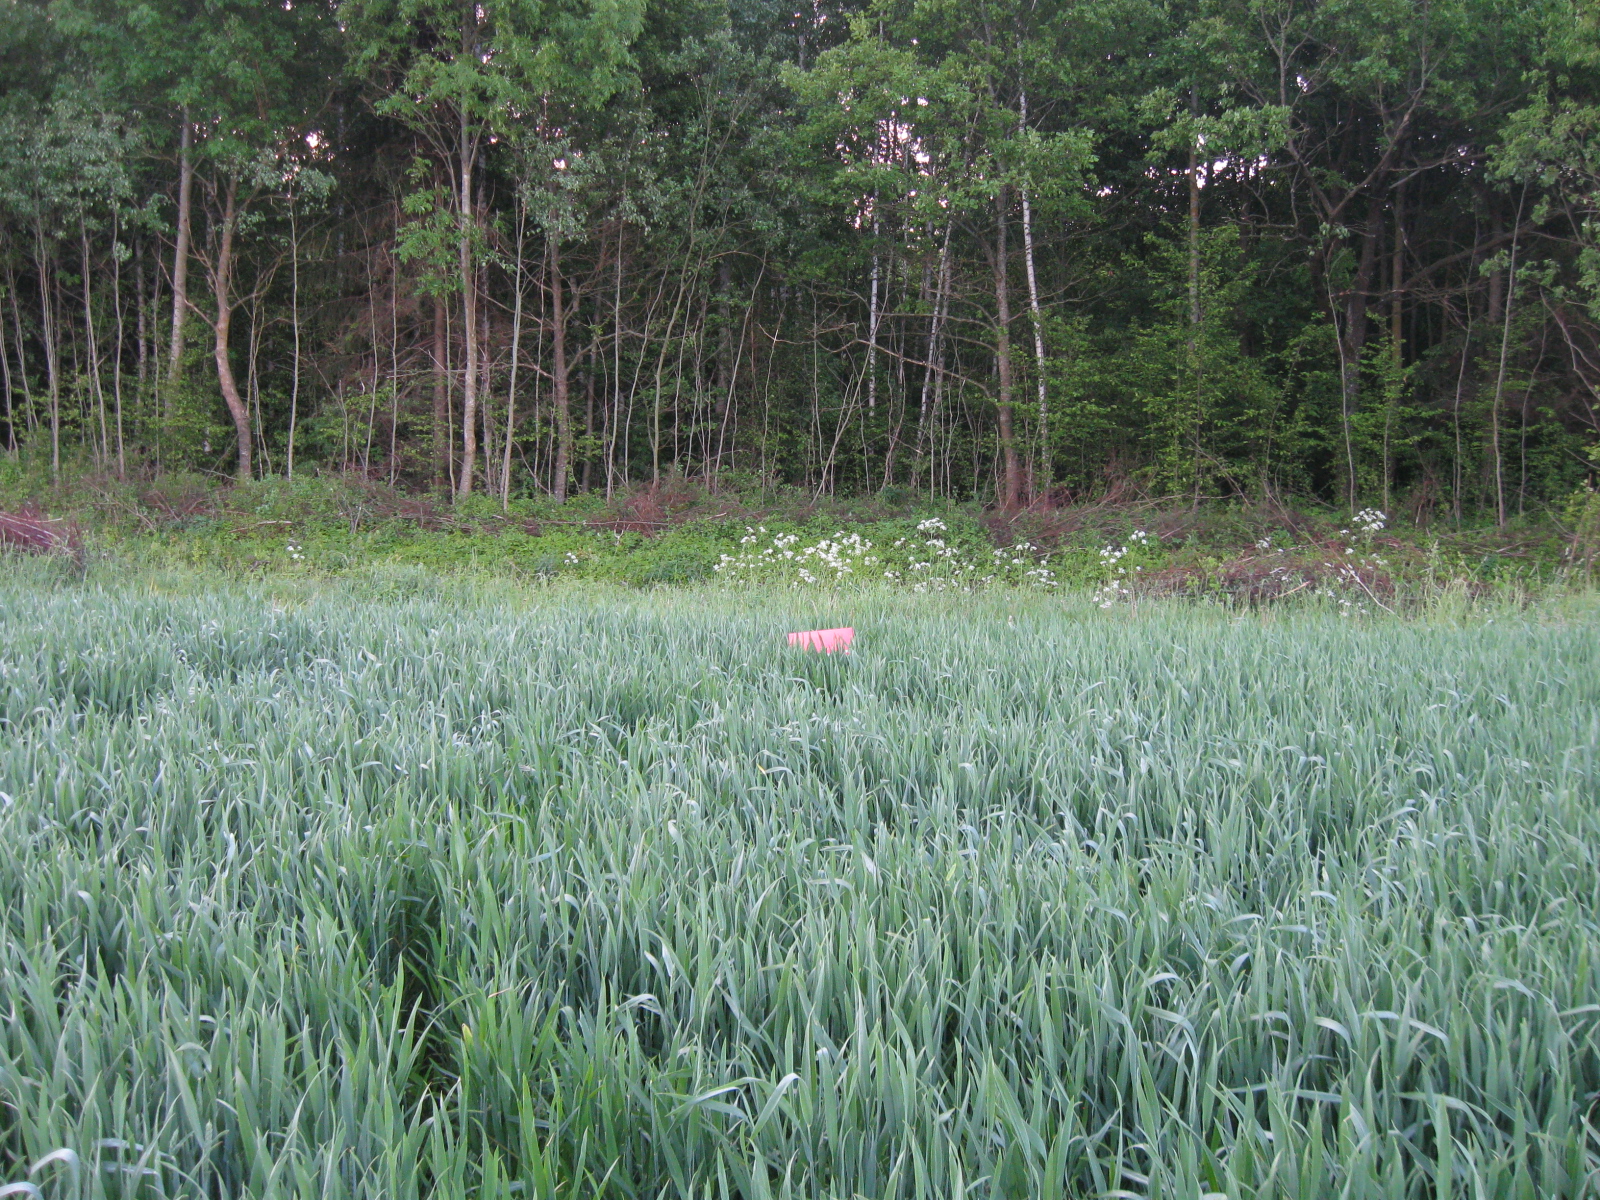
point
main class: Cropland
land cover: Common wheat
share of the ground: > 75 %
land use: Agriculture (excluding fallow land and kitchen gardens)
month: June
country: LT
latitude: 54.4685
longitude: 23.8049
